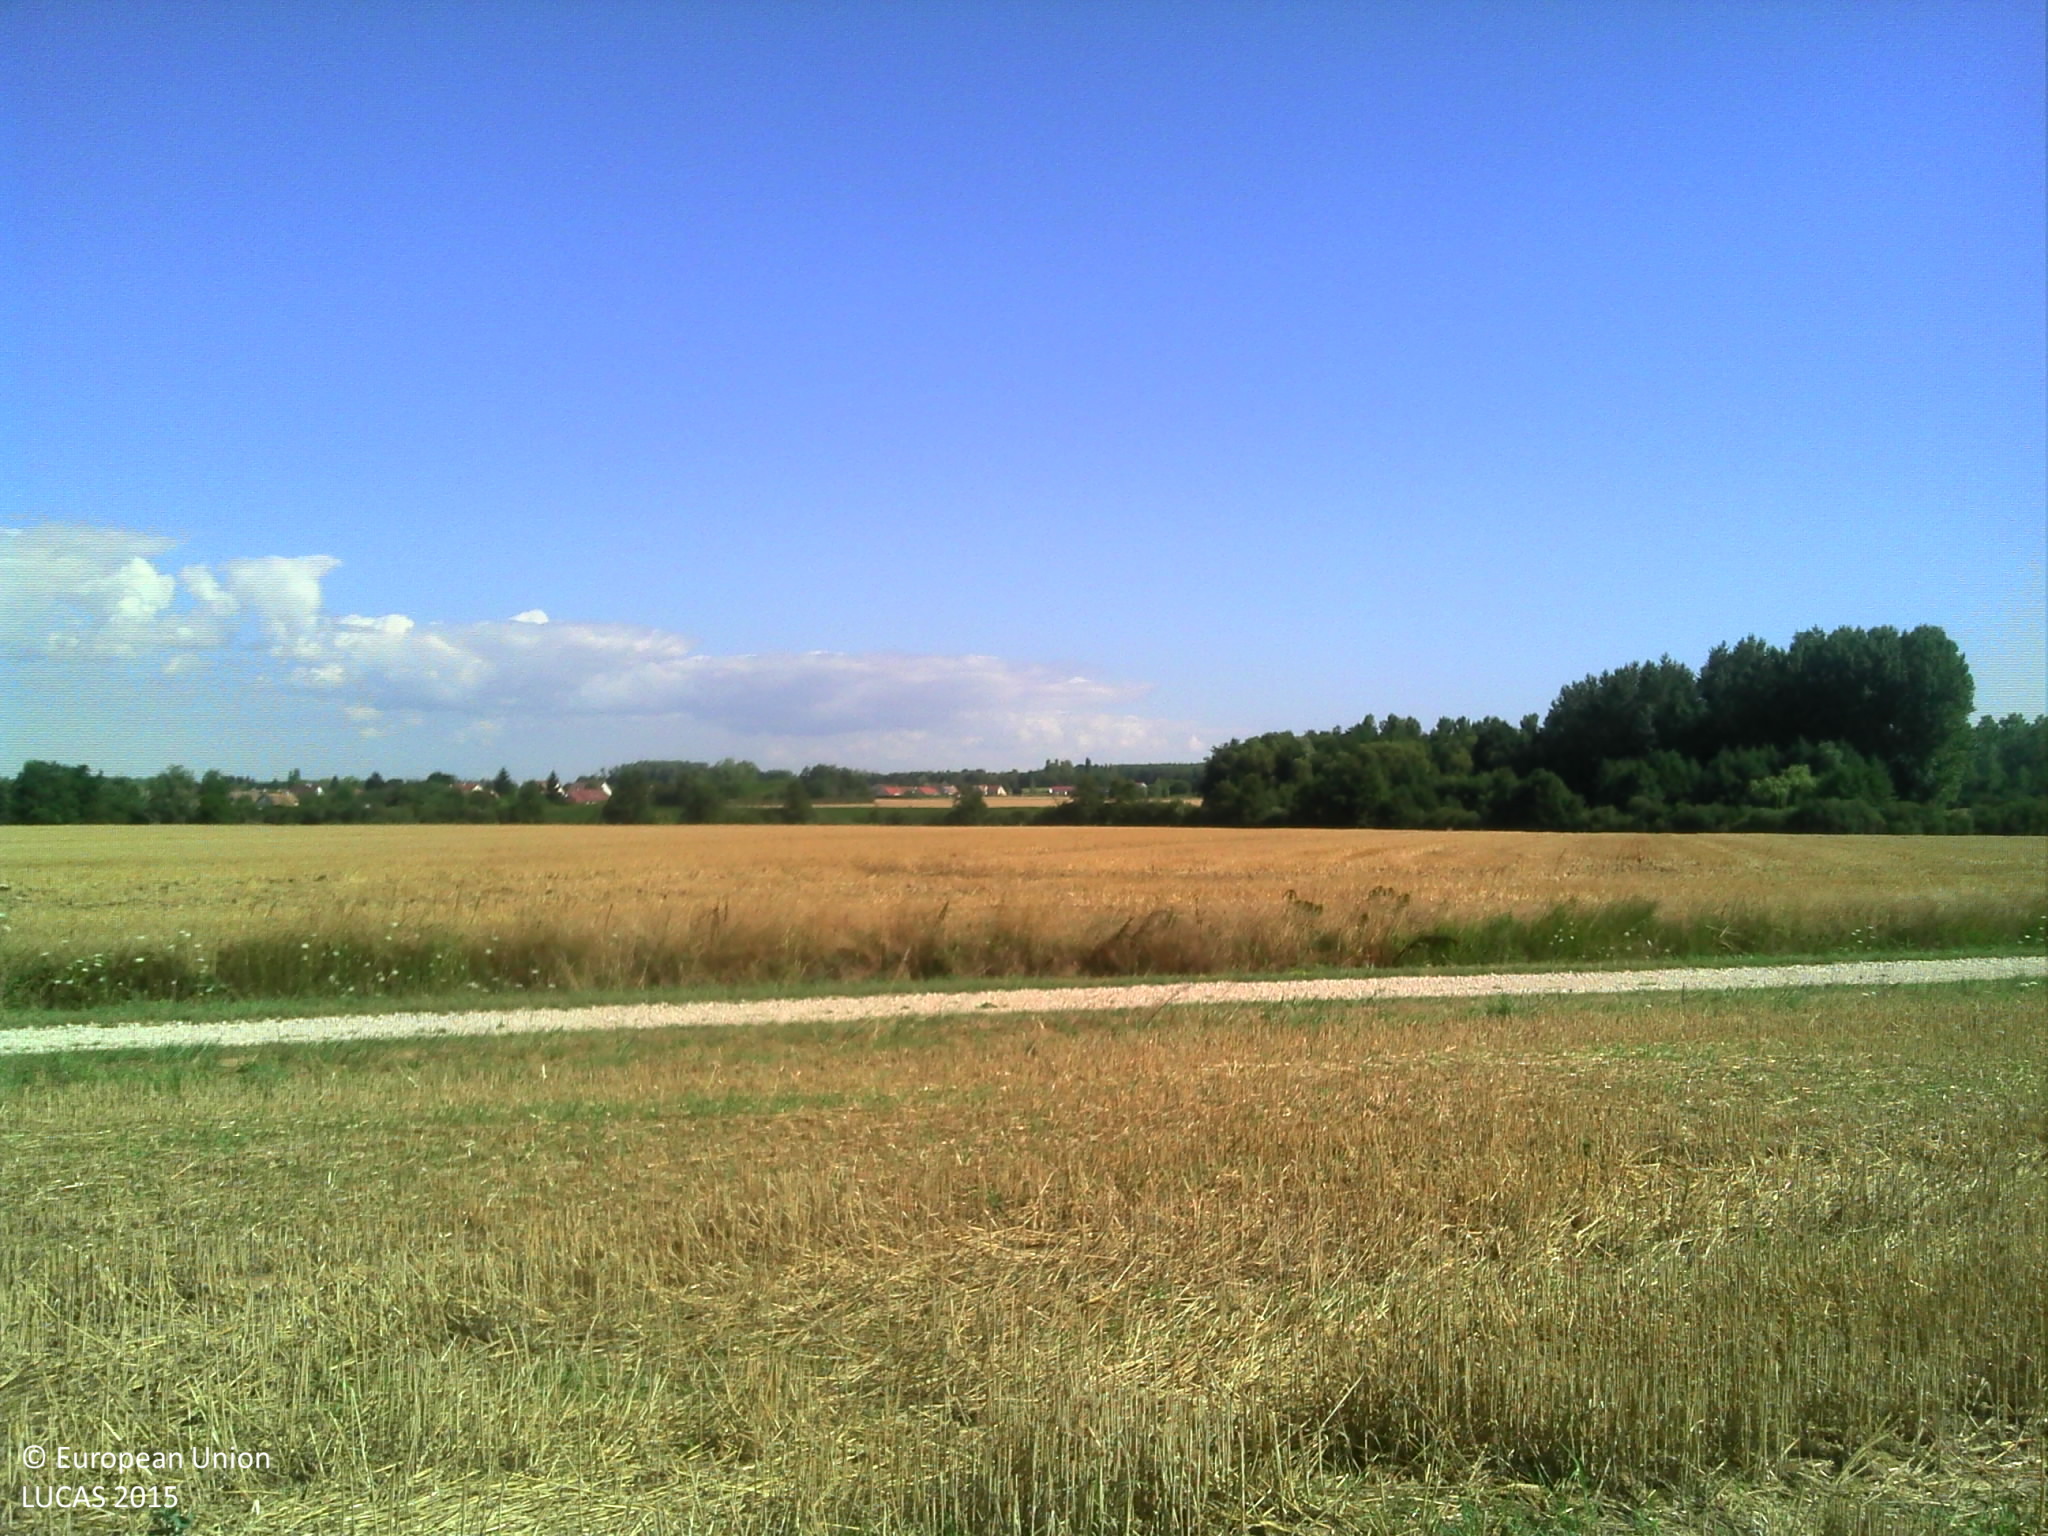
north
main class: Cropland
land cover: Common wheat
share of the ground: > 75 %
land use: Agriculture (excluding fallow land and kitchen gardens)
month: July
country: FR
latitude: 46.7725
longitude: 4.9334
